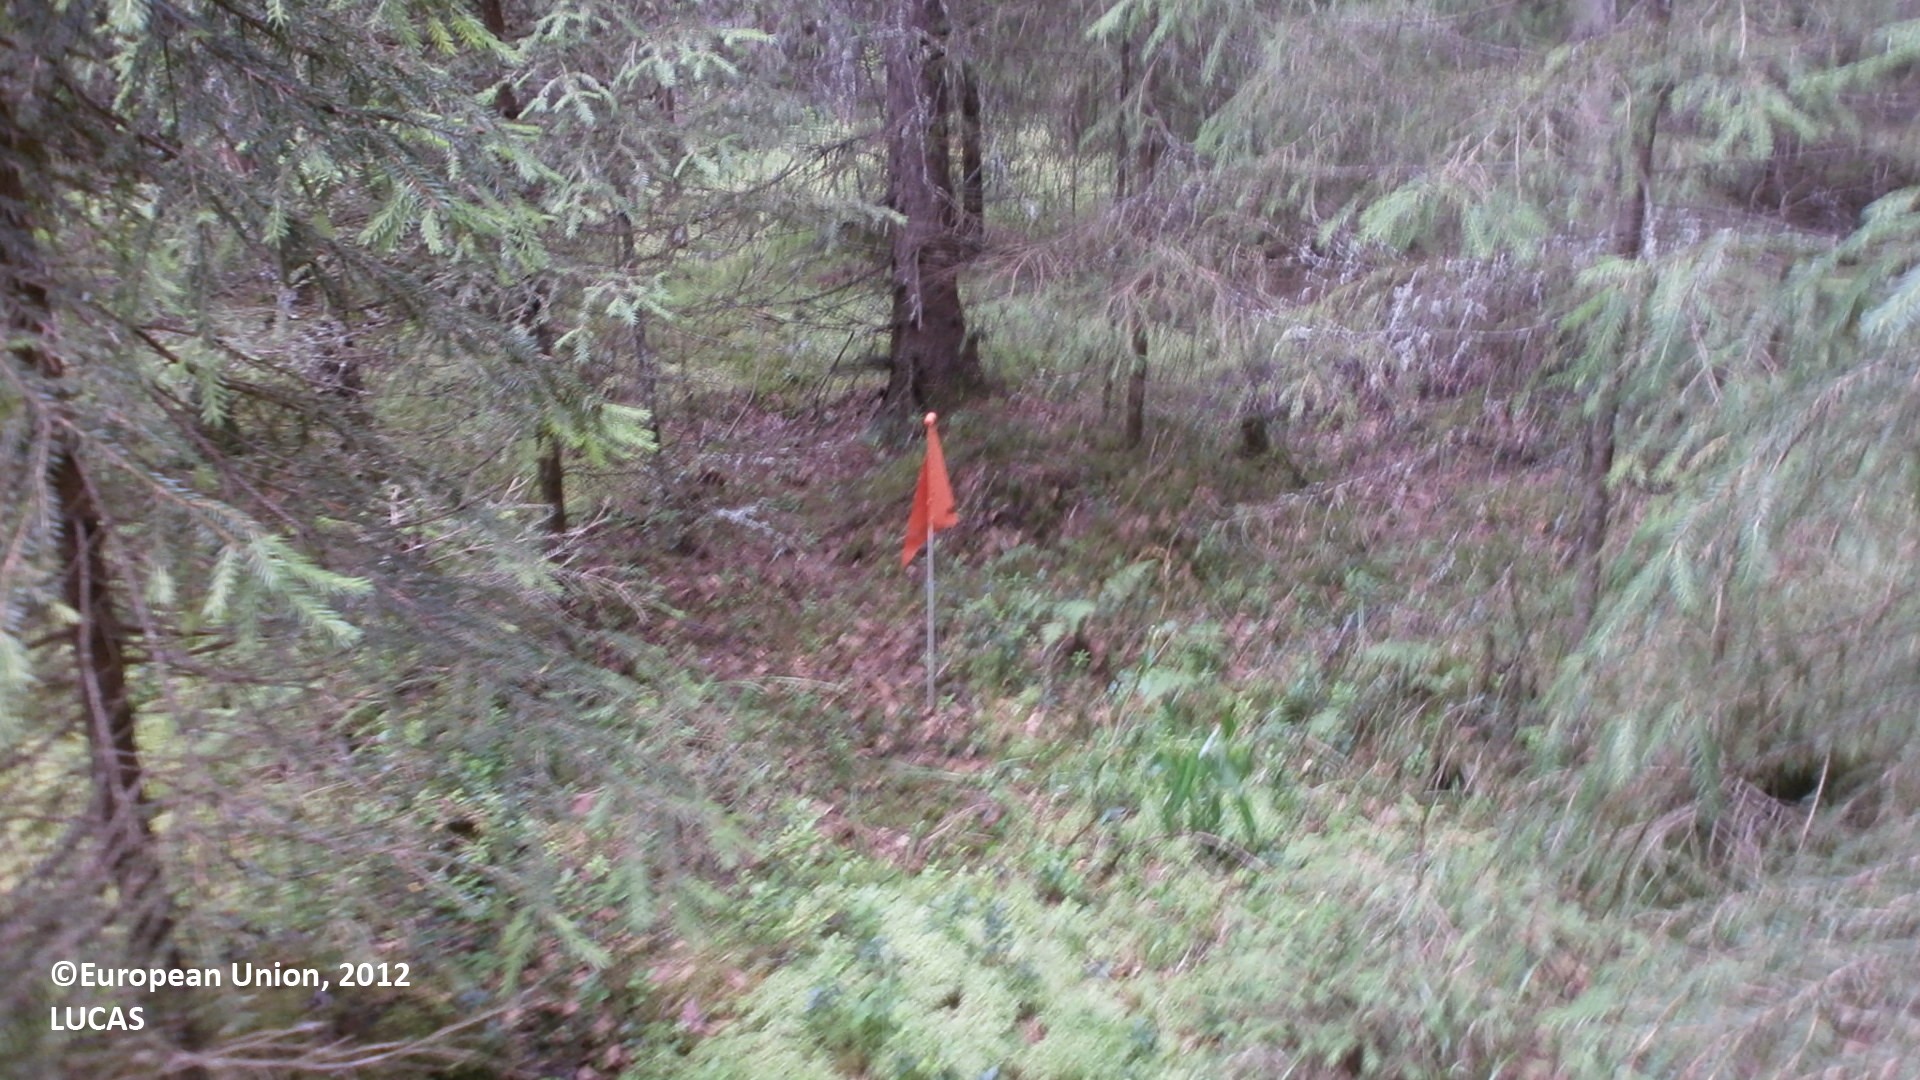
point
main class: Woodland
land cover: Spruce dominated mixed woodland
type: boreal forest
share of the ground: > 75 %
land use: Forestry
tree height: > 5 m
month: July
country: FI
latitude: 64.2137
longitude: 24.2215
